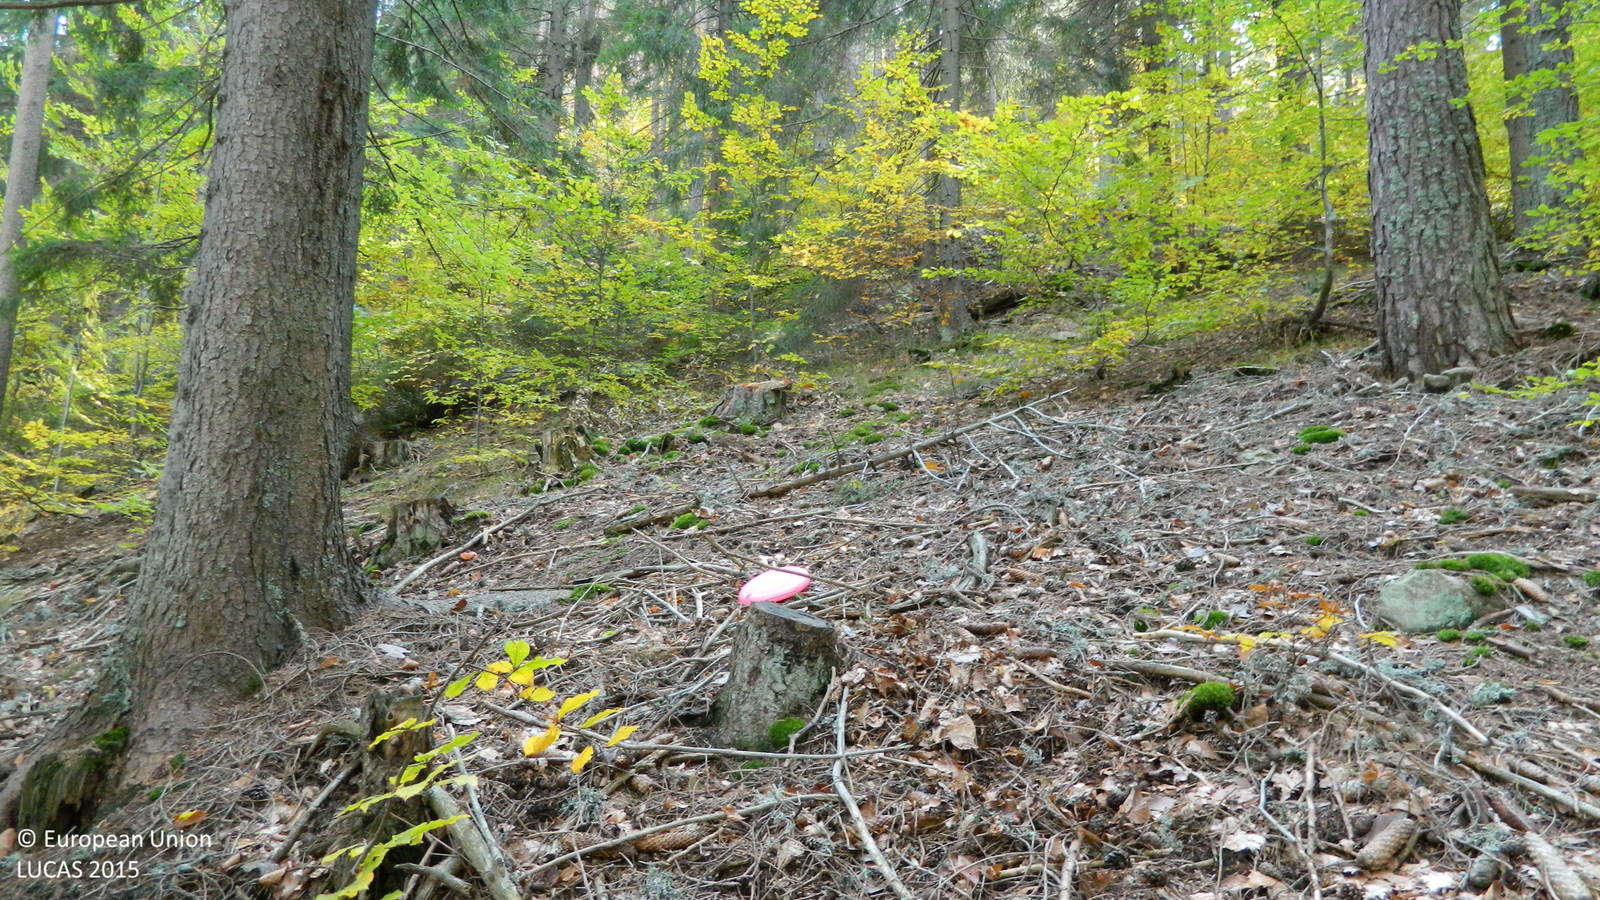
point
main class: Woodland
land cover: Spruce dominated mixed woodland
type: alpine coniferous forest
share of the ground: > 75 %
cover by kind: coniferous forest trees 75 %, broadleaved forest trees 25 %
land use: Forestry
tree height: > 5 m
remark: Clear cut
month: October
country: BG
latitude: 41.6934
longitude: 24.8874
